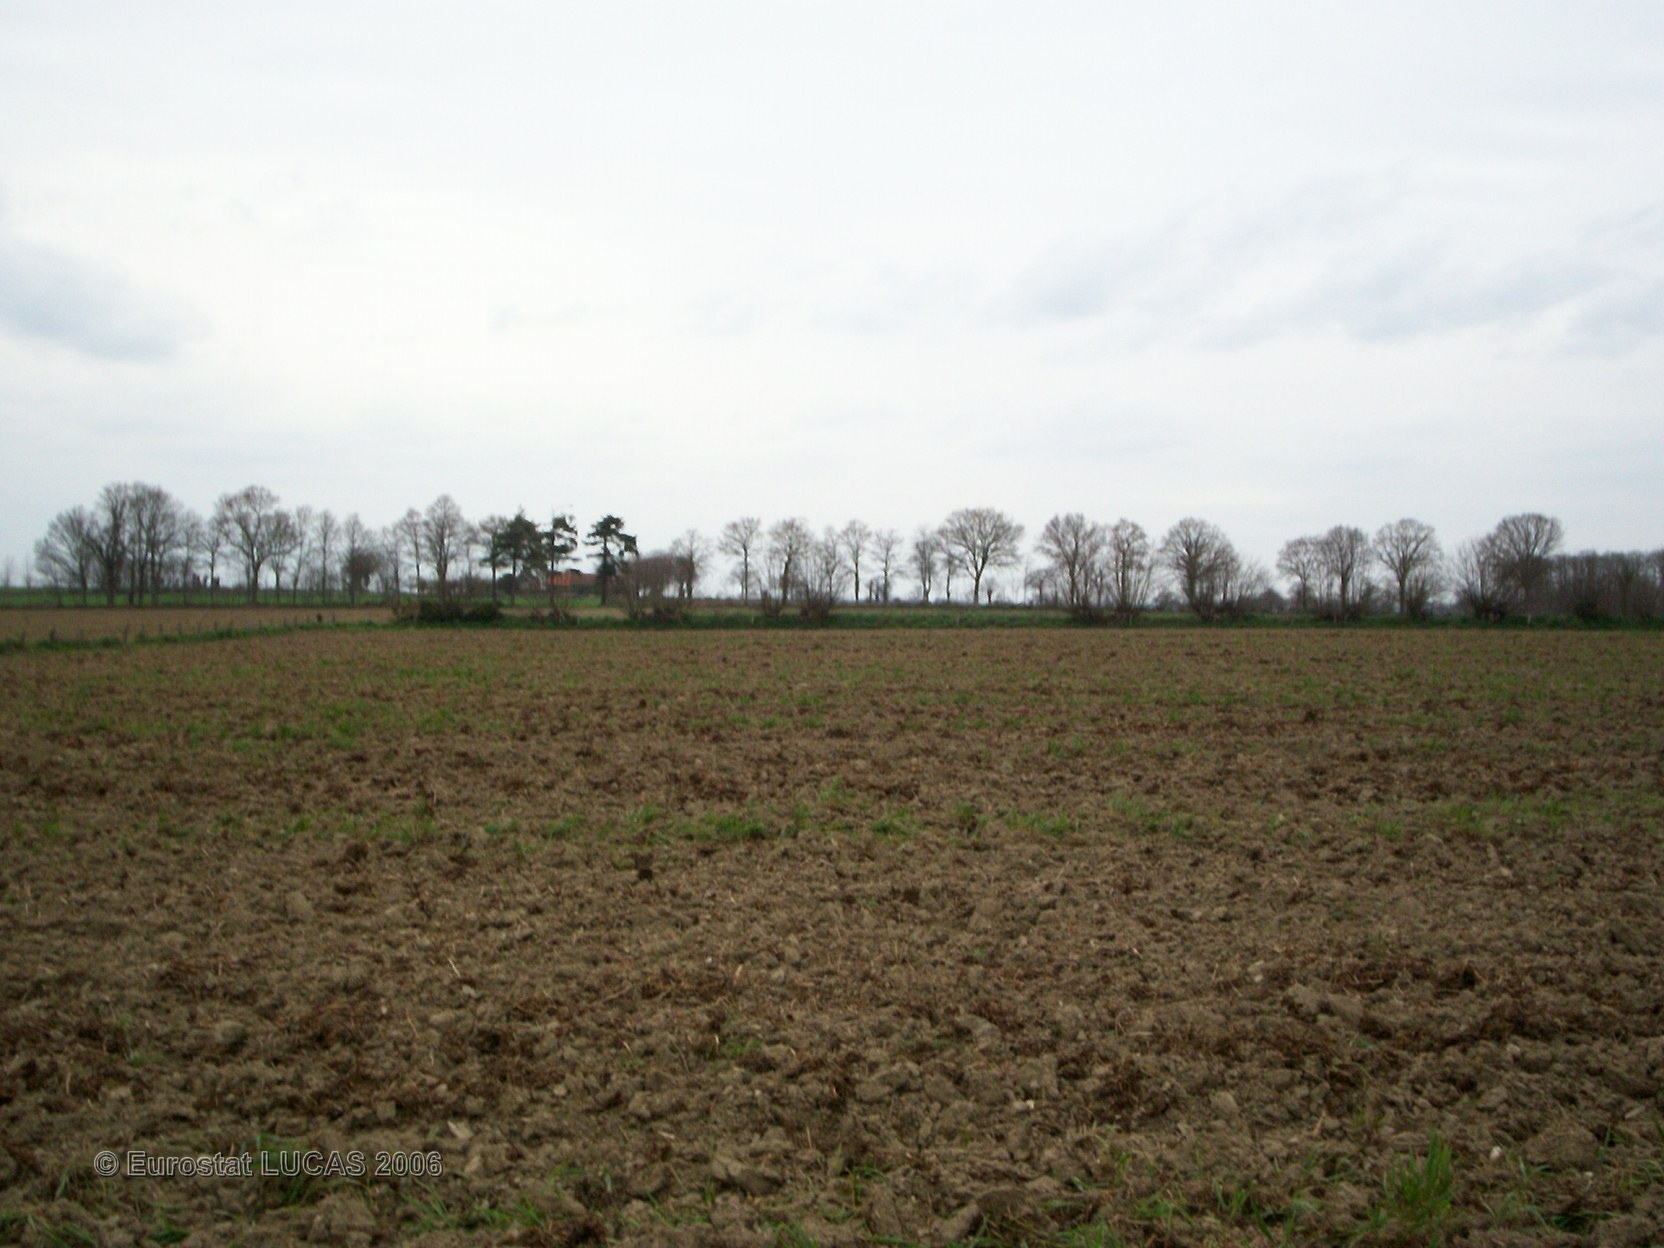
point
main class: Cropland
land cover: Maize
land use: Agriculture (excluding fallow land and kitchen gardens)
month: April
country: FR
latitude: 48.4816
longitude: -1.4237
